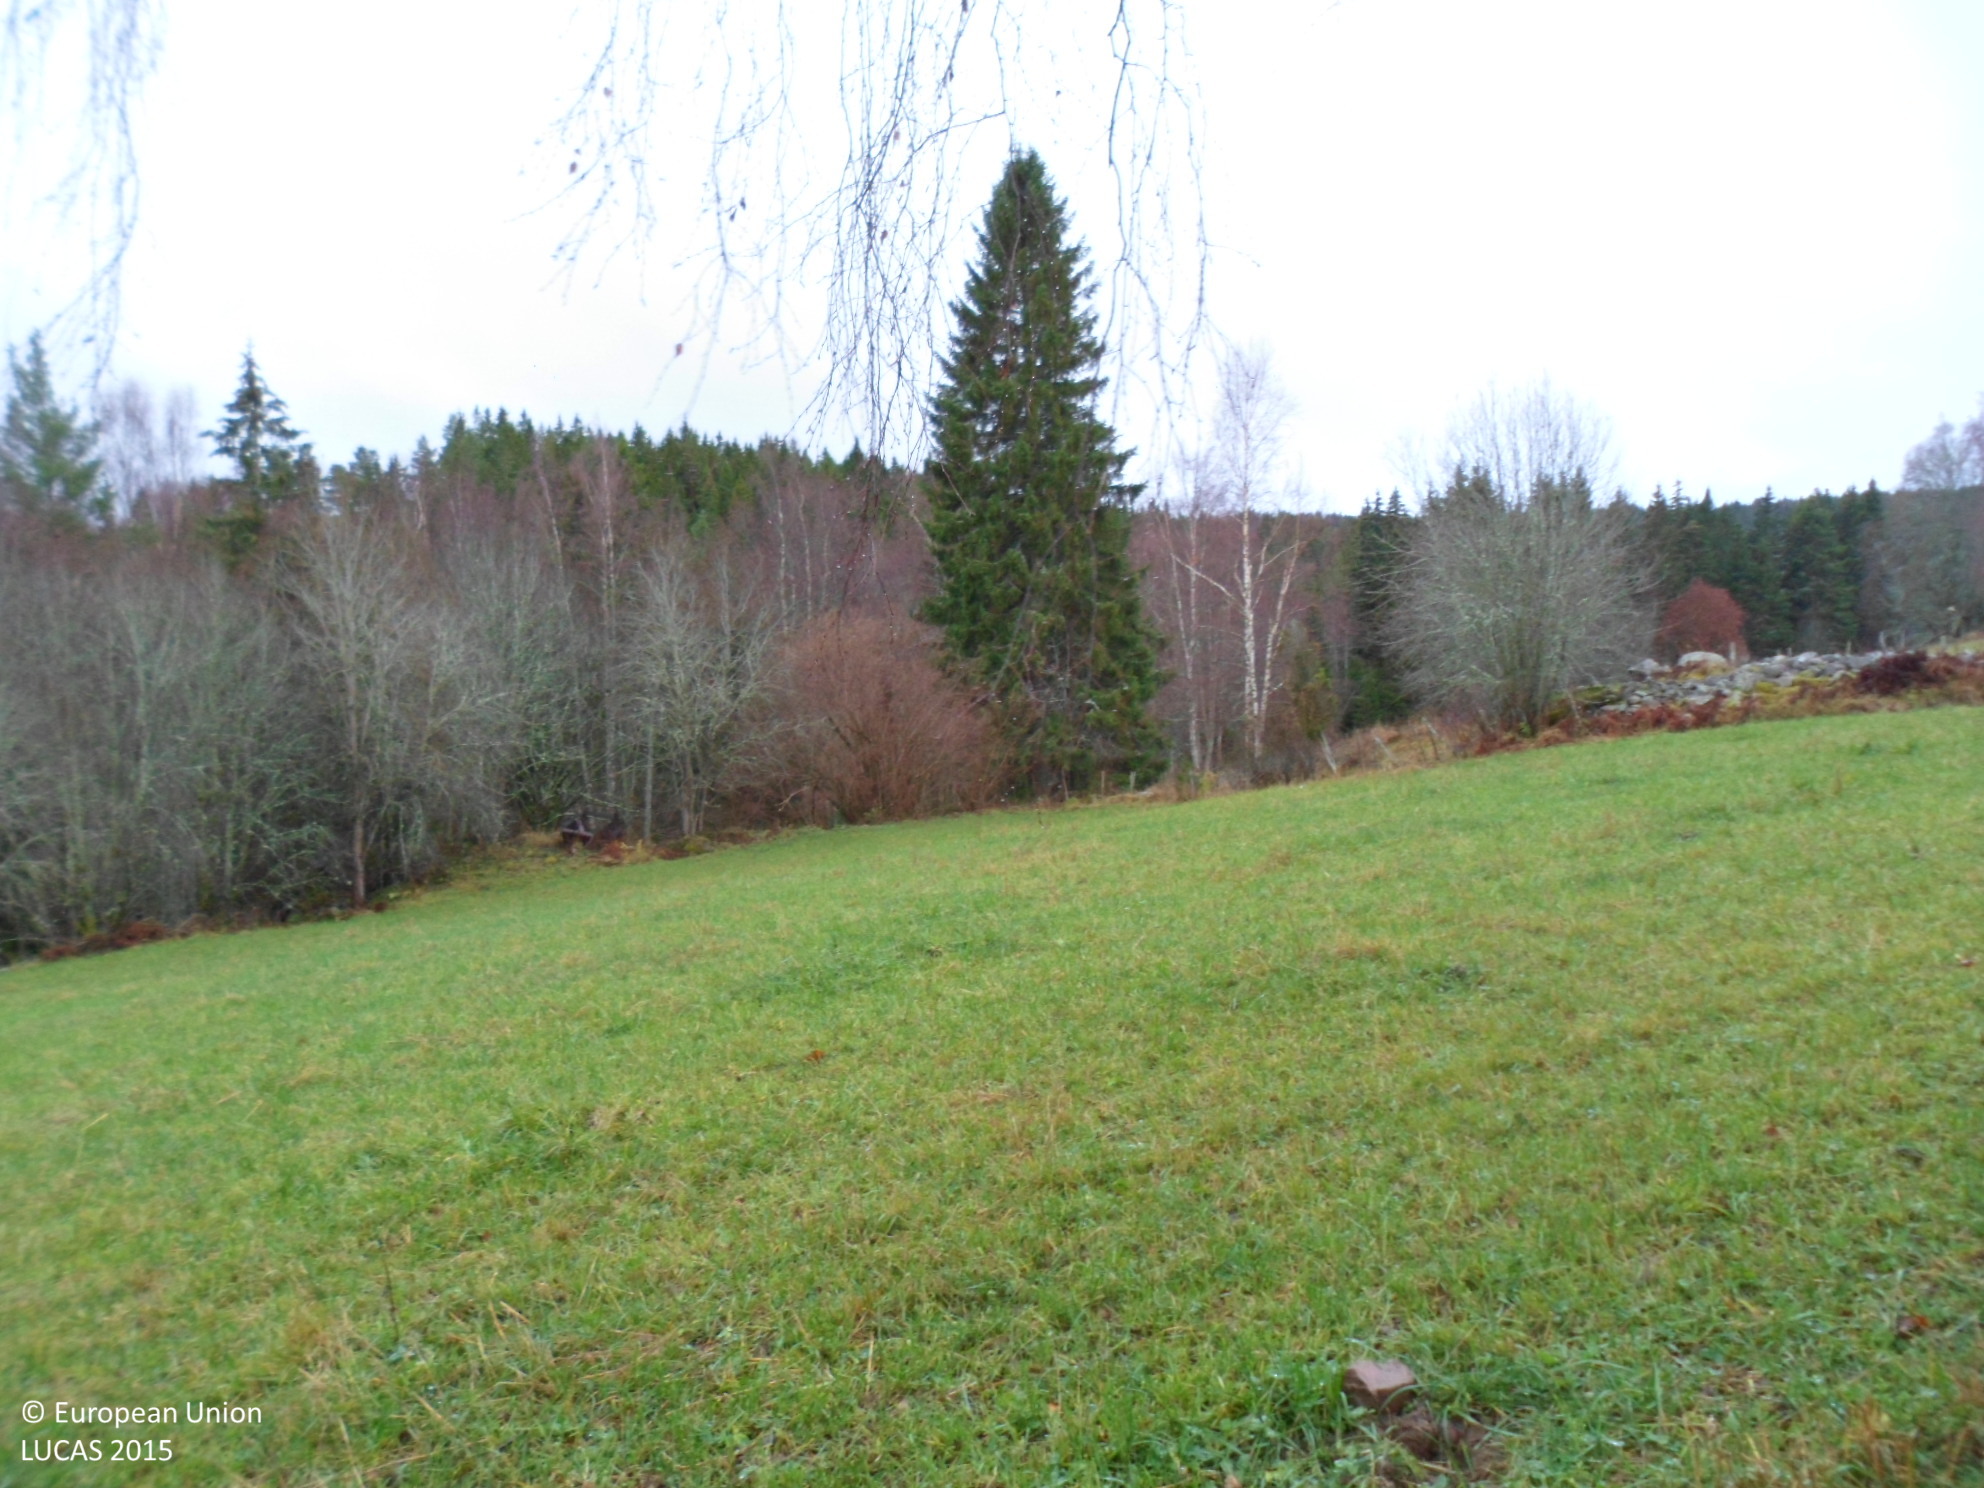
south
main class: Grassland
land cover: Grassland with sparse tree/shrub cover
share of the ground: > 75 %
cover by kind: herbaceous plants 80 %, lichens and mosses 10 %, broadleaved forest trees 5 %, shrubs 5 %
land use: Agriculture (excluding fallow land and kitchen gardens)
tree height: > 5 m
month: November
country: SE
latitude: 57.9951
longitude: 14.6469
